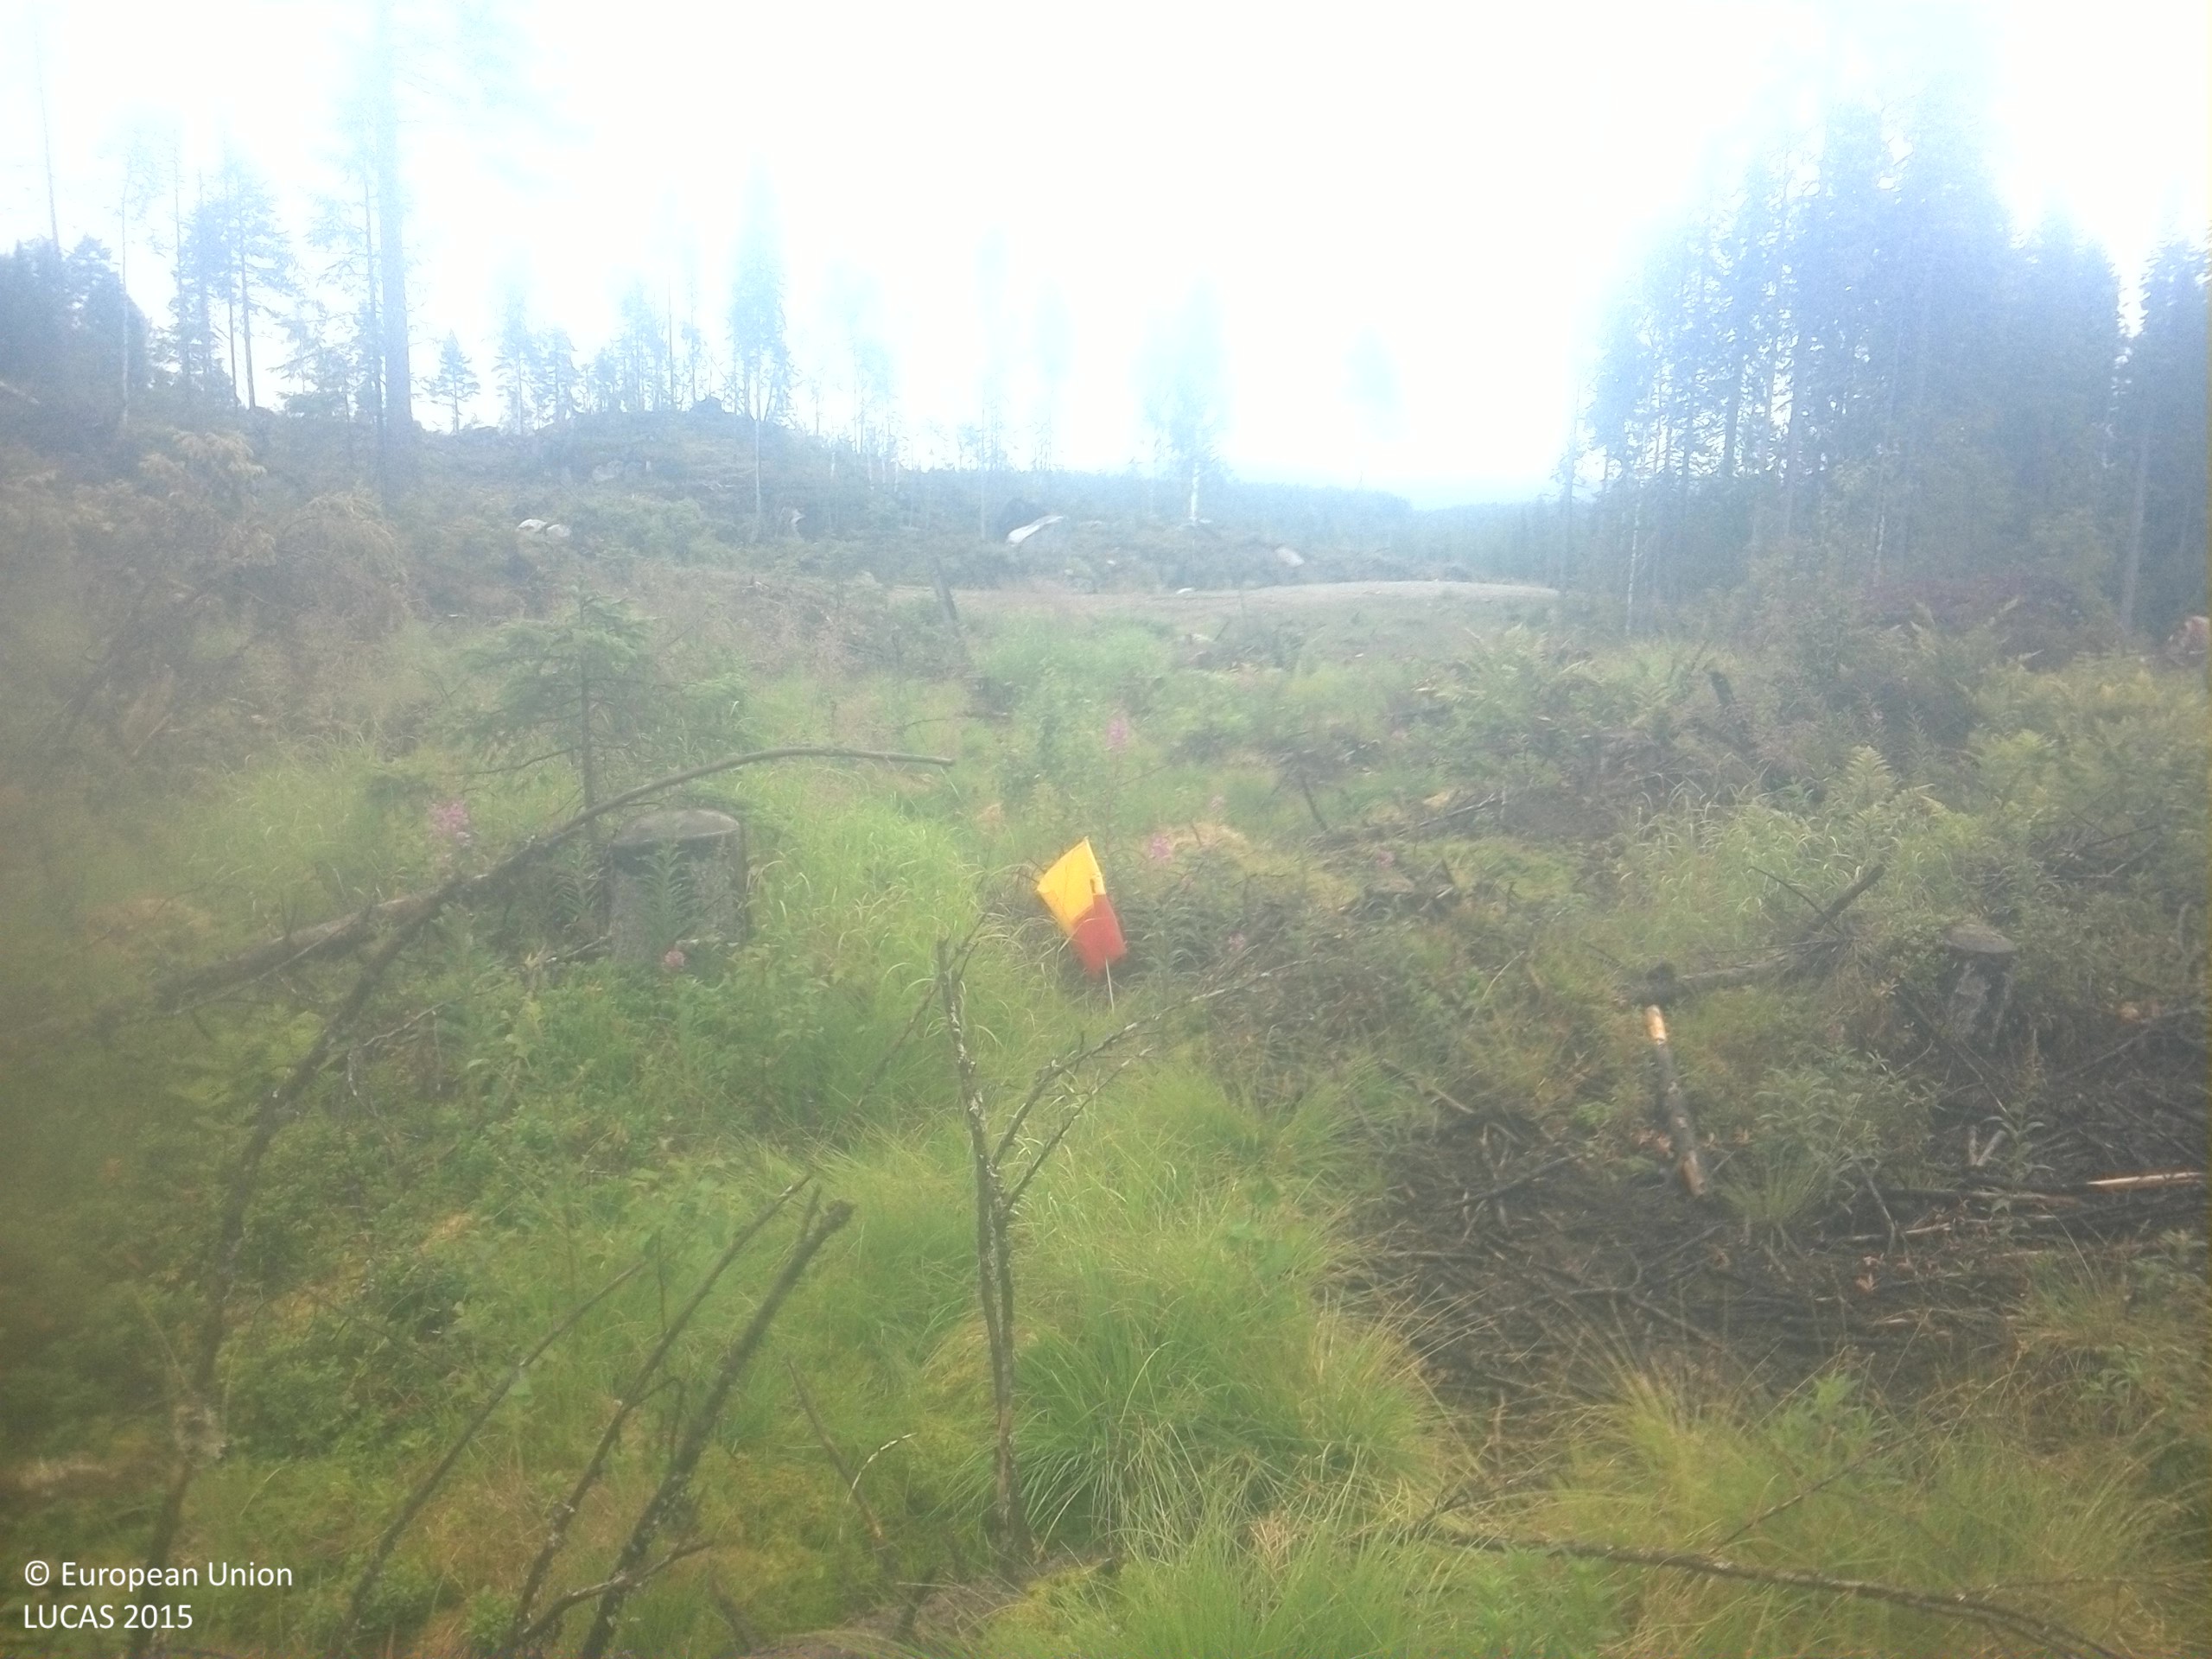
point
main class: Shrubland
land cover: Shrubland with sparse tree cover
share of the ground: 10 - 25 %
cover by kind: herbaceous plants 35 %, shrubs 20 %, lichens and mosses 15 %, unconsolidated bare surface 15 %, consolidated bare surface 10 %, coniferous forest trees 5 %
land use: Forestry
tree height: < 5 m
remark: Clear cut
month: August
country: SE
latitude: 63.5560
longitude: 16.5550
